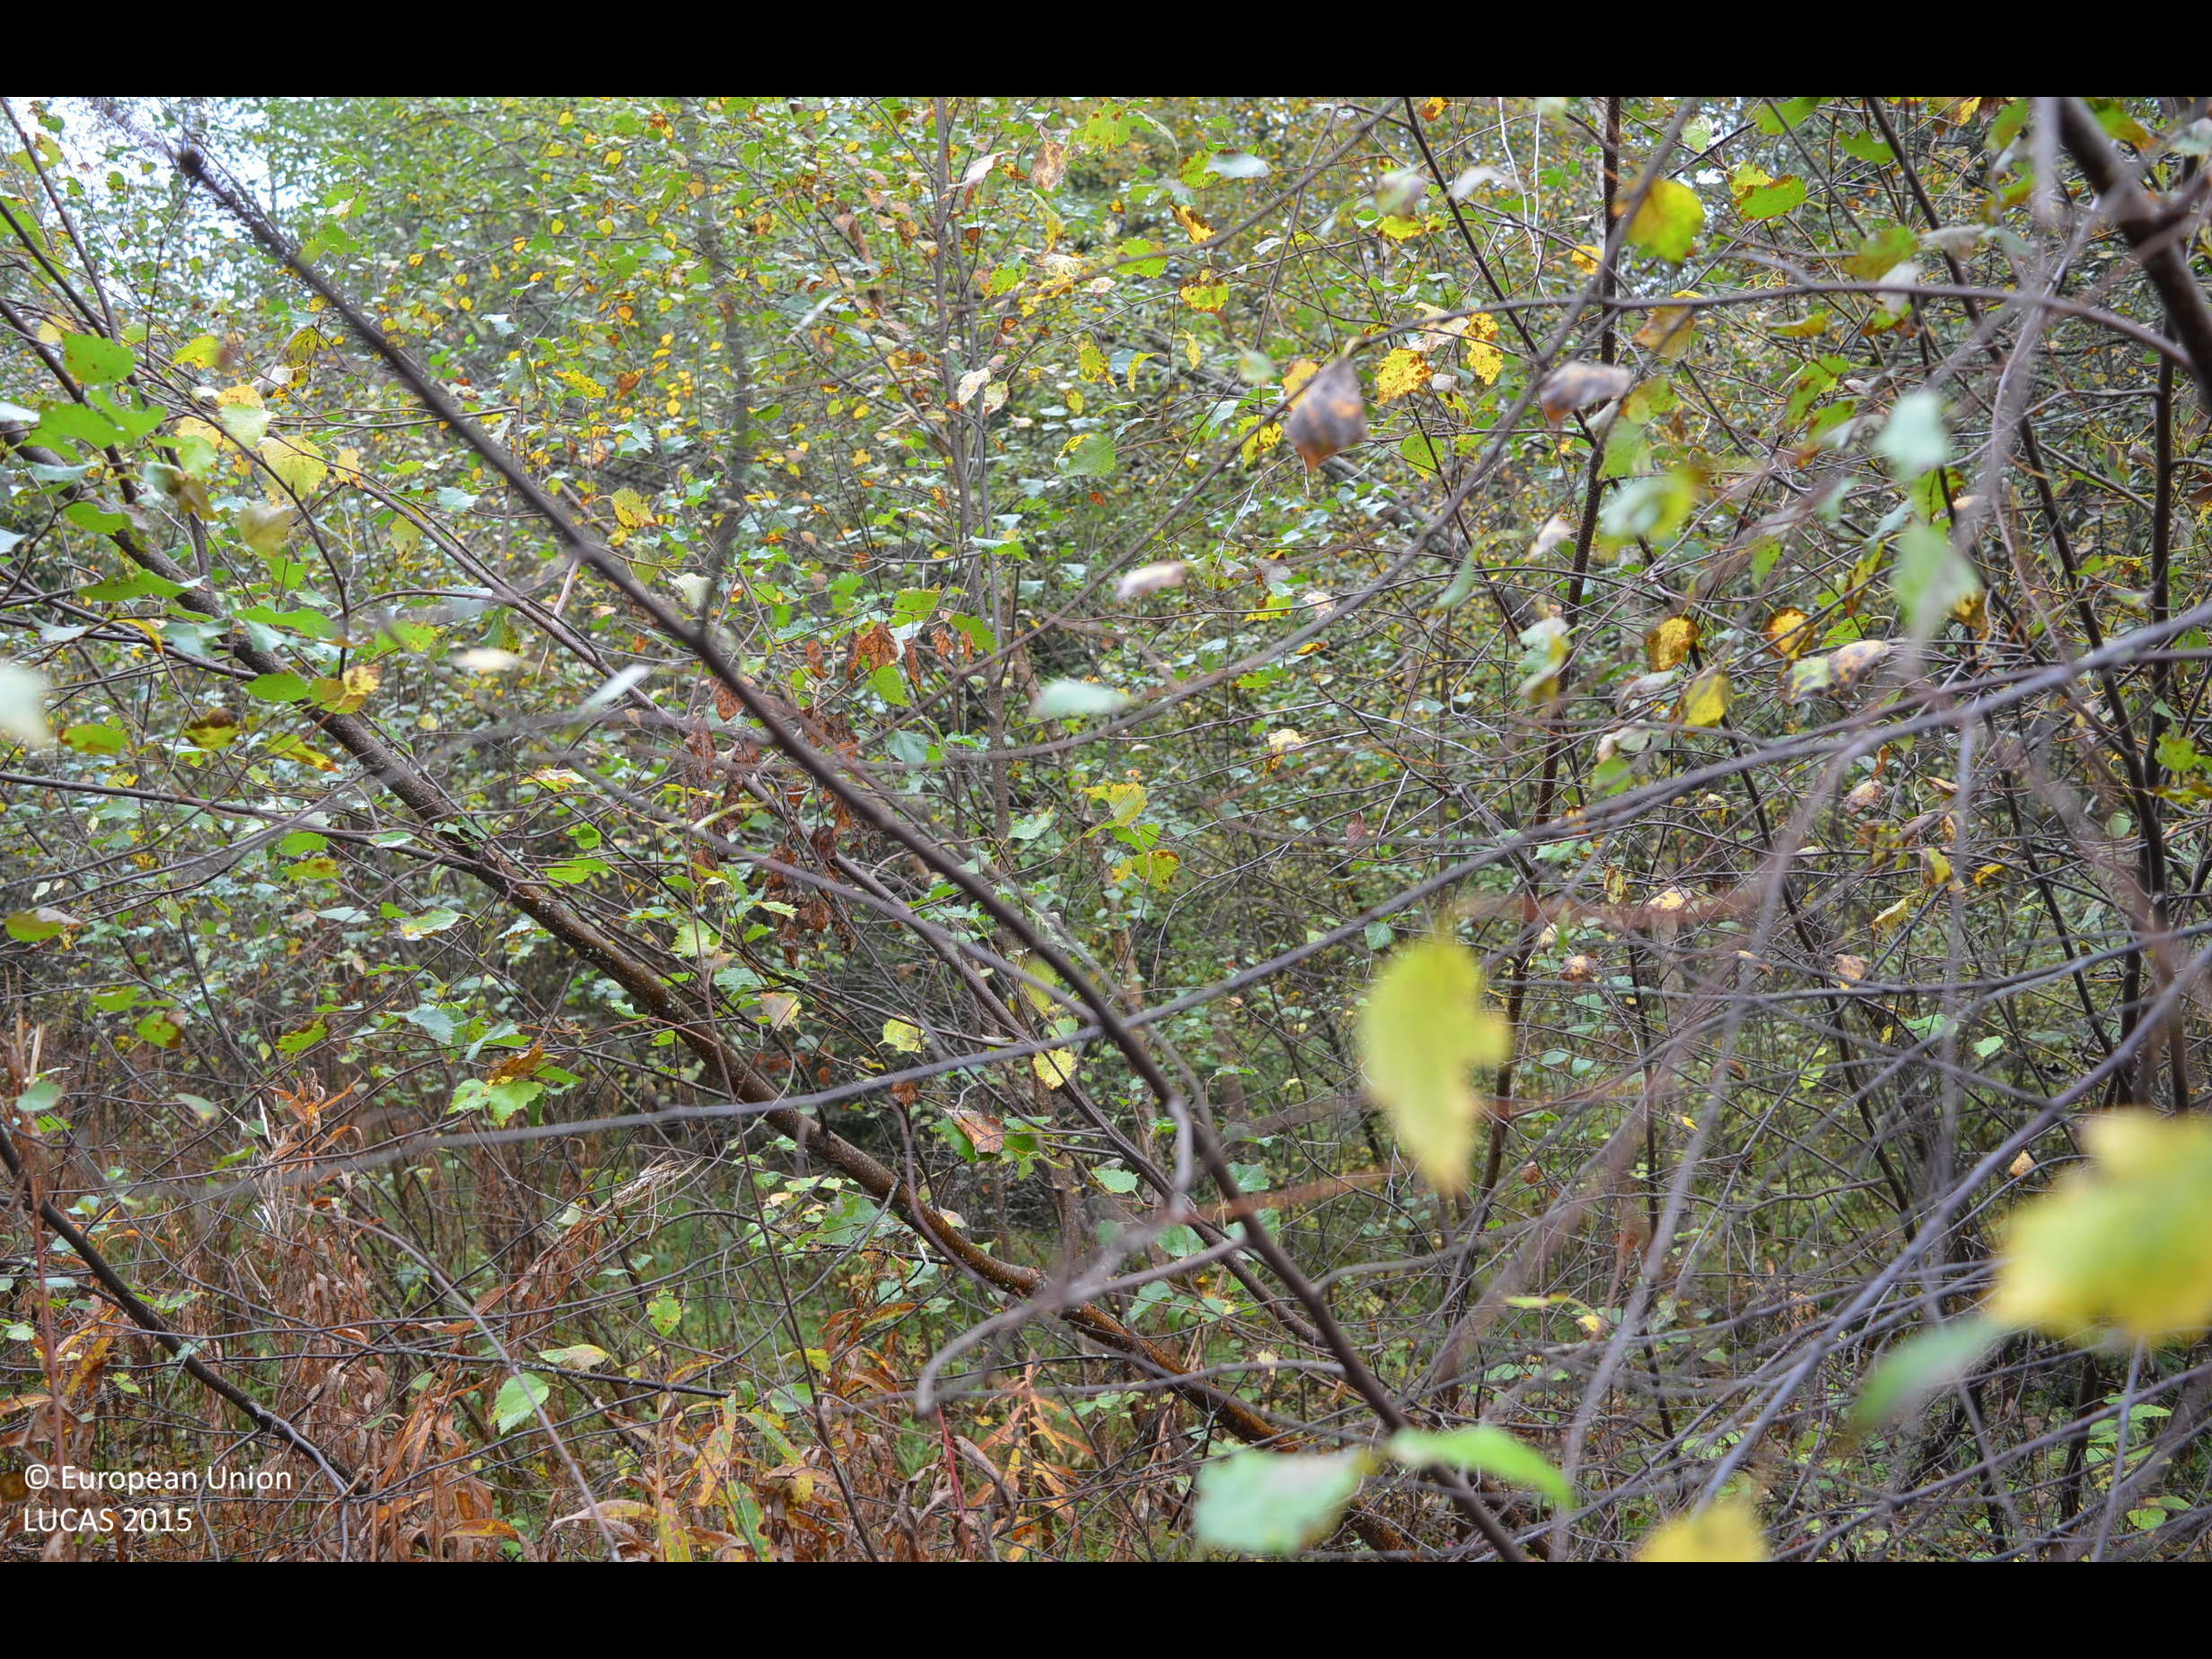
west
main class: Woodland
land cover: Broadleaved woodland
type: boreal forest
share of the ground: > 75 %
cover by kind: broadleaved forest trees 80 %, coniferous forest trees 15 %, shrubs 5 %
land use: Forestry
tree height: < 5 m
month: September
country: FI
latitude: 62.6881
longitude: 23.8083
